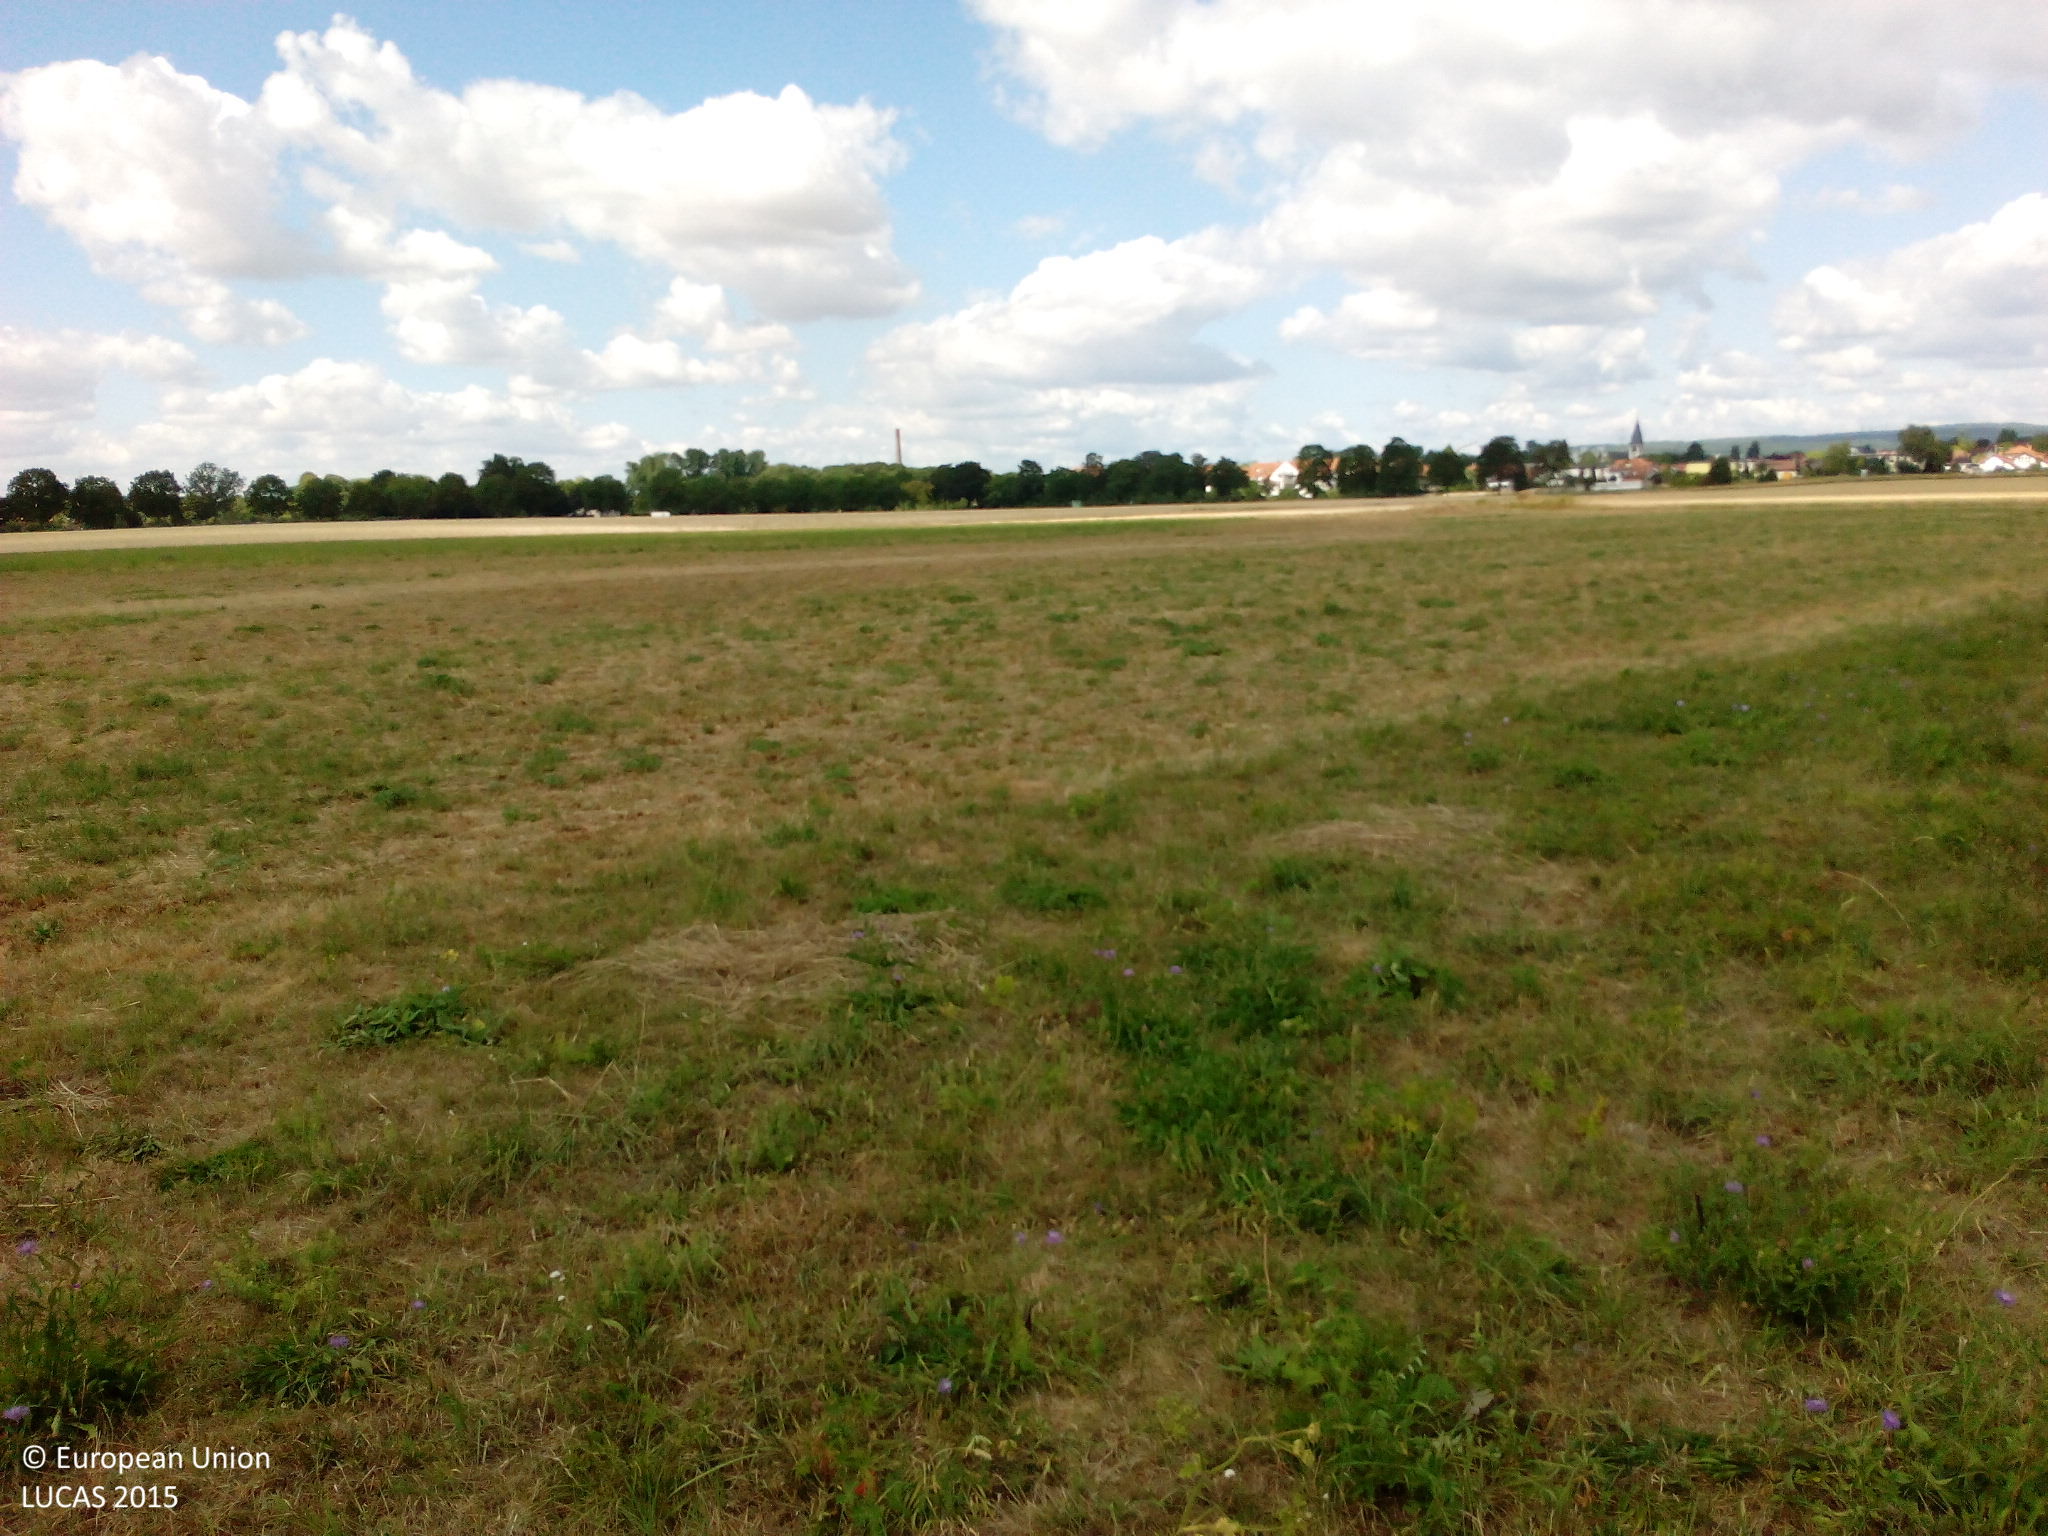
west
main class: Grassland
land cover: Grassland without tree/shrub cover
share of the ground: > 75 %
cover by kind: herbaceous plants 90 %, unconsolidated bare surface 10 %
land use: Agriculture (excluding fallow land and kitchen gardens)
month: July
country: DE
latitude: 50.0665
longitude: 8.5056
